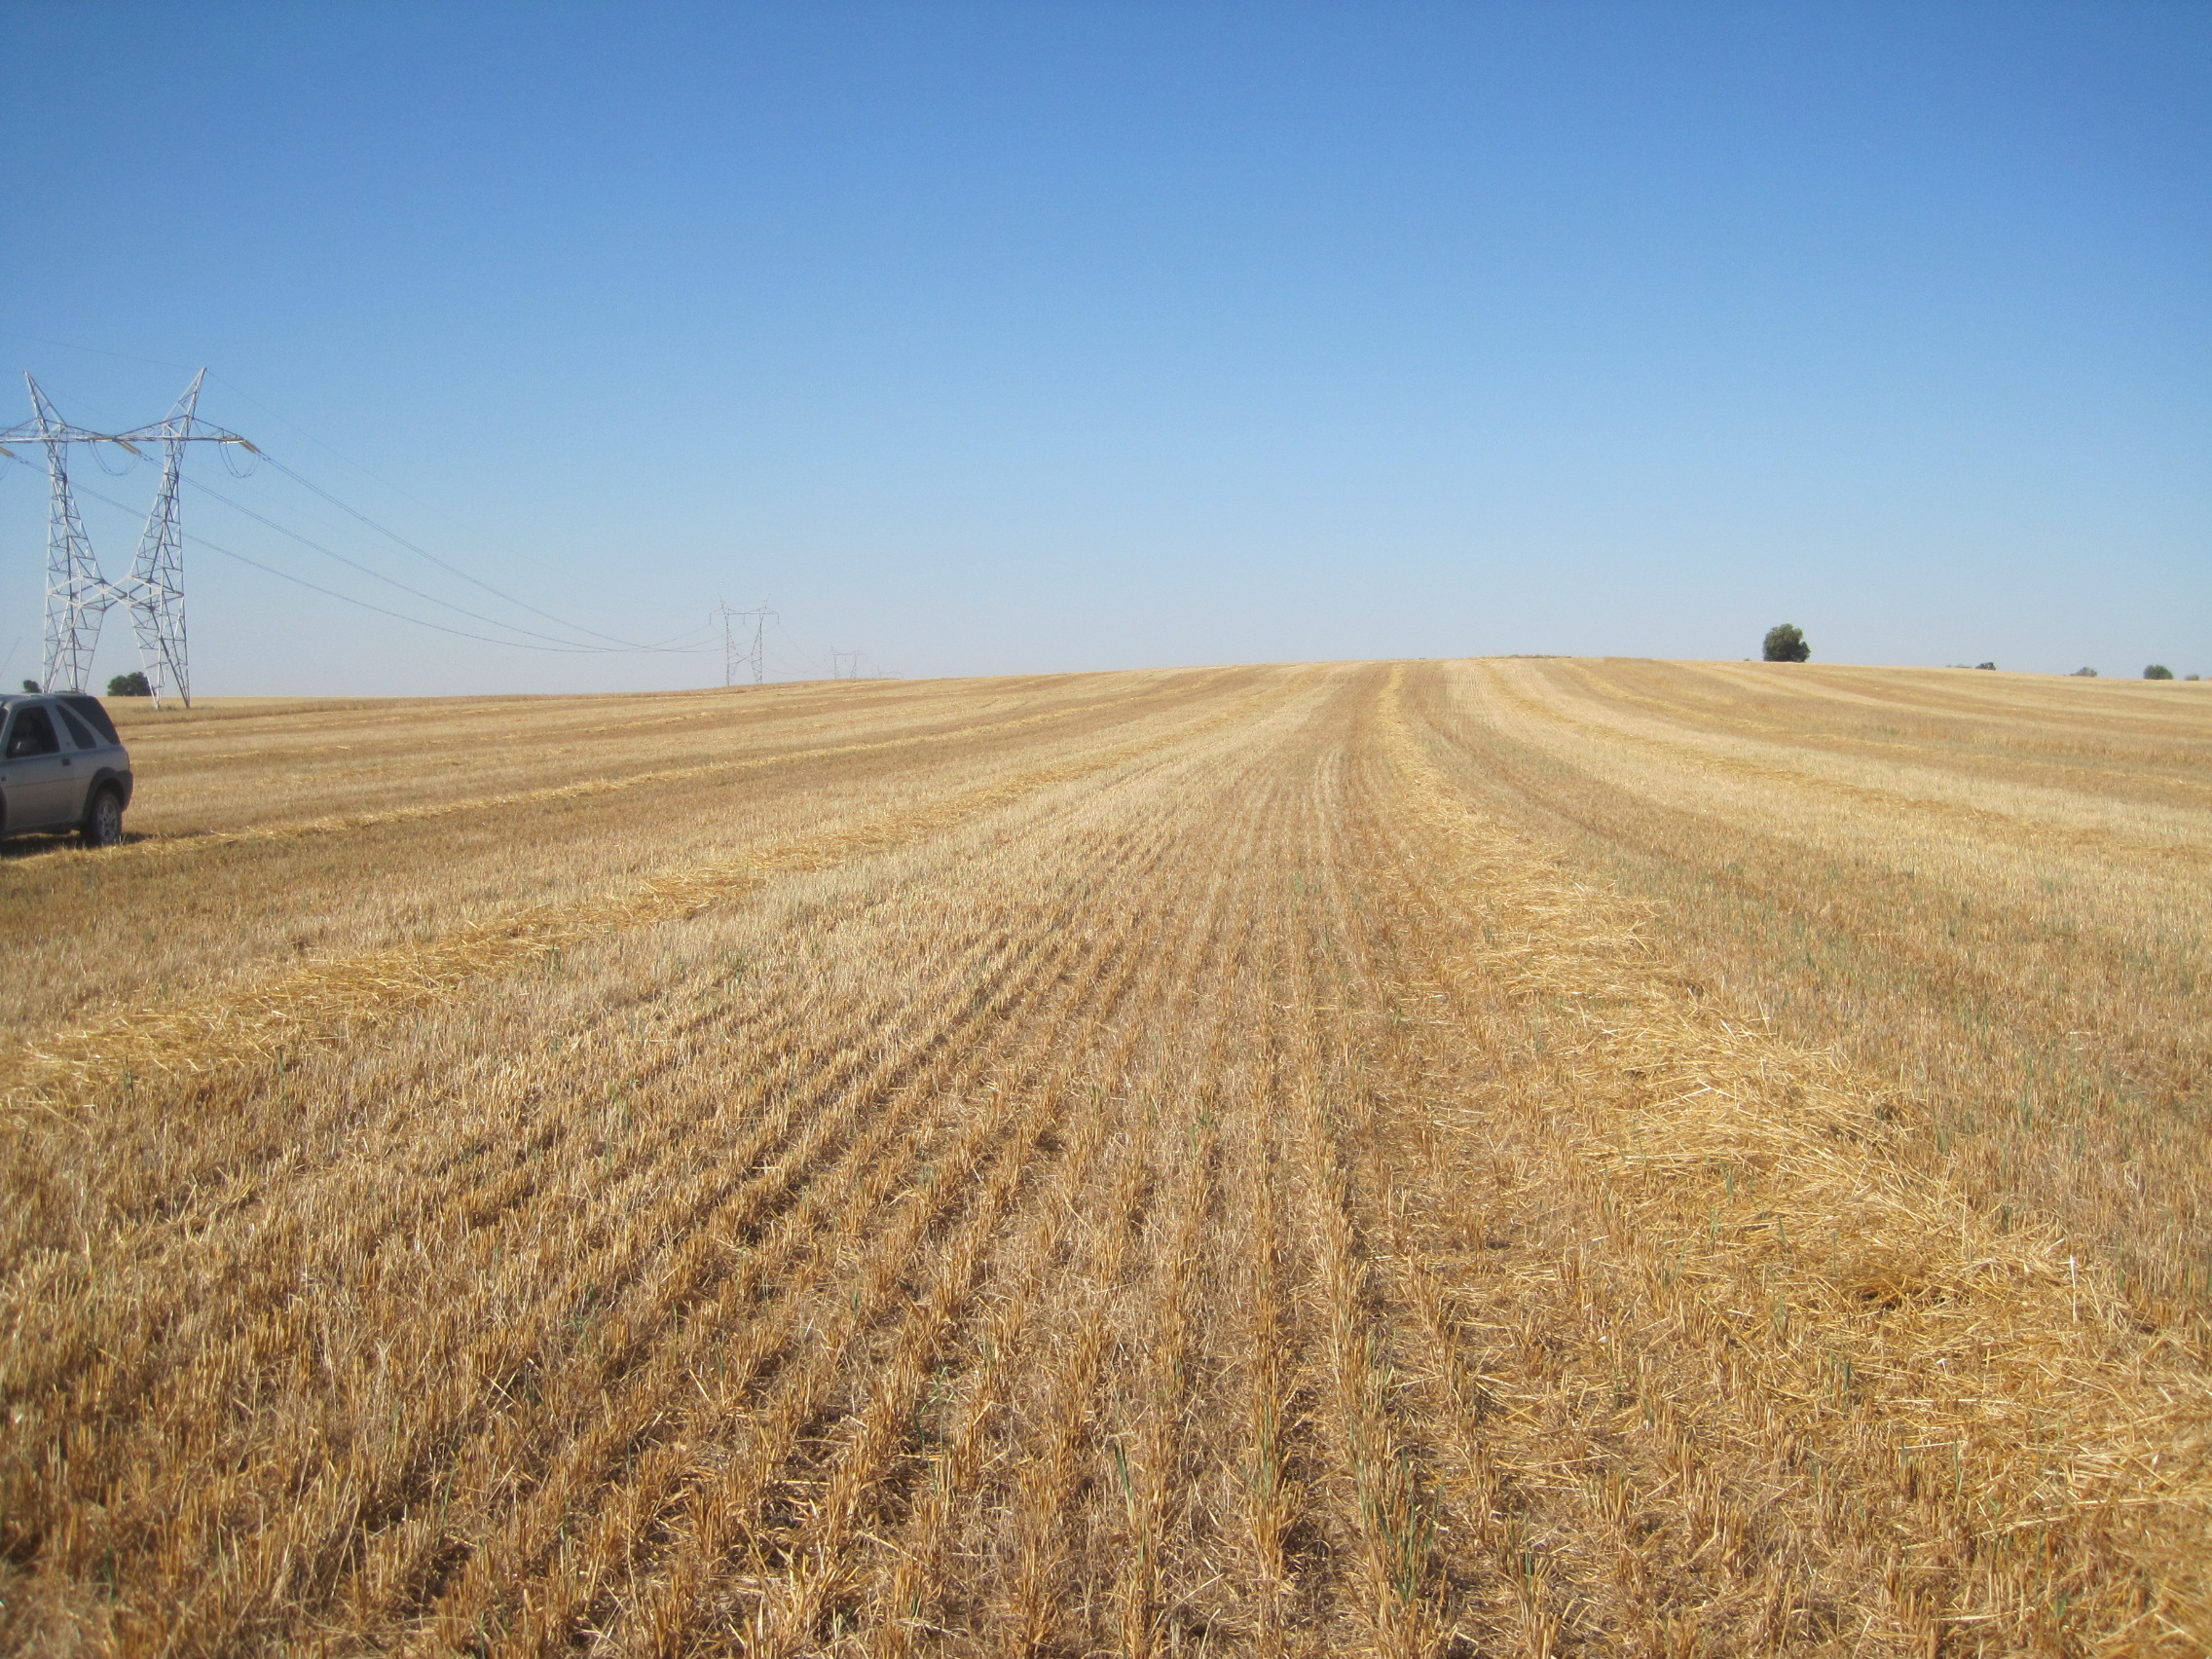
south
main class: Cropland
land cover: Oats
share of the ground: < 10 %
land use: Agriculture (excluding fallow land and kitchen gardens)
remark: Harvested field
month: July
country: ES
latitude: 41.8844
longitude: -4.8365
